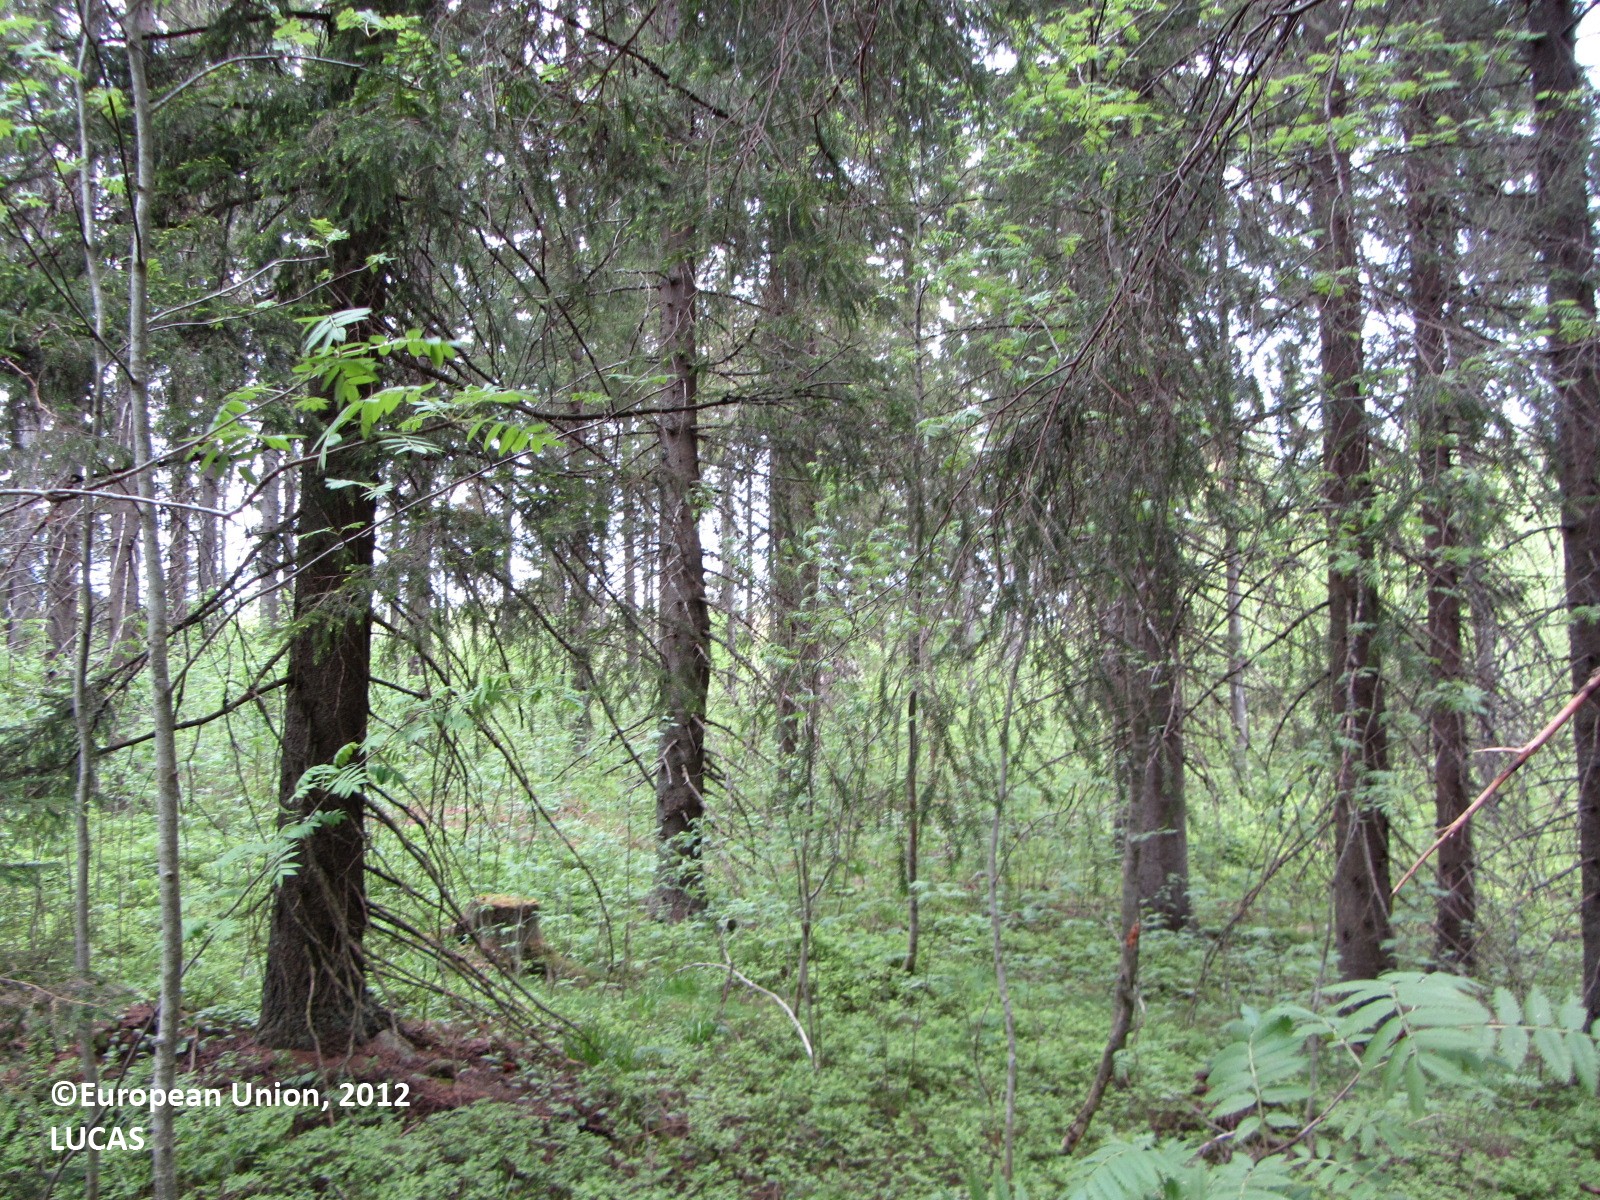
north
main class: Woodland
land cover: Spruce dominated mixed woodland
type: boreal forest
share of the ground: > 75 %
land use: Forestry
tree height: > 5 m
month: May
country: FI
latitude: 62.3060
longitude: 25.4459
